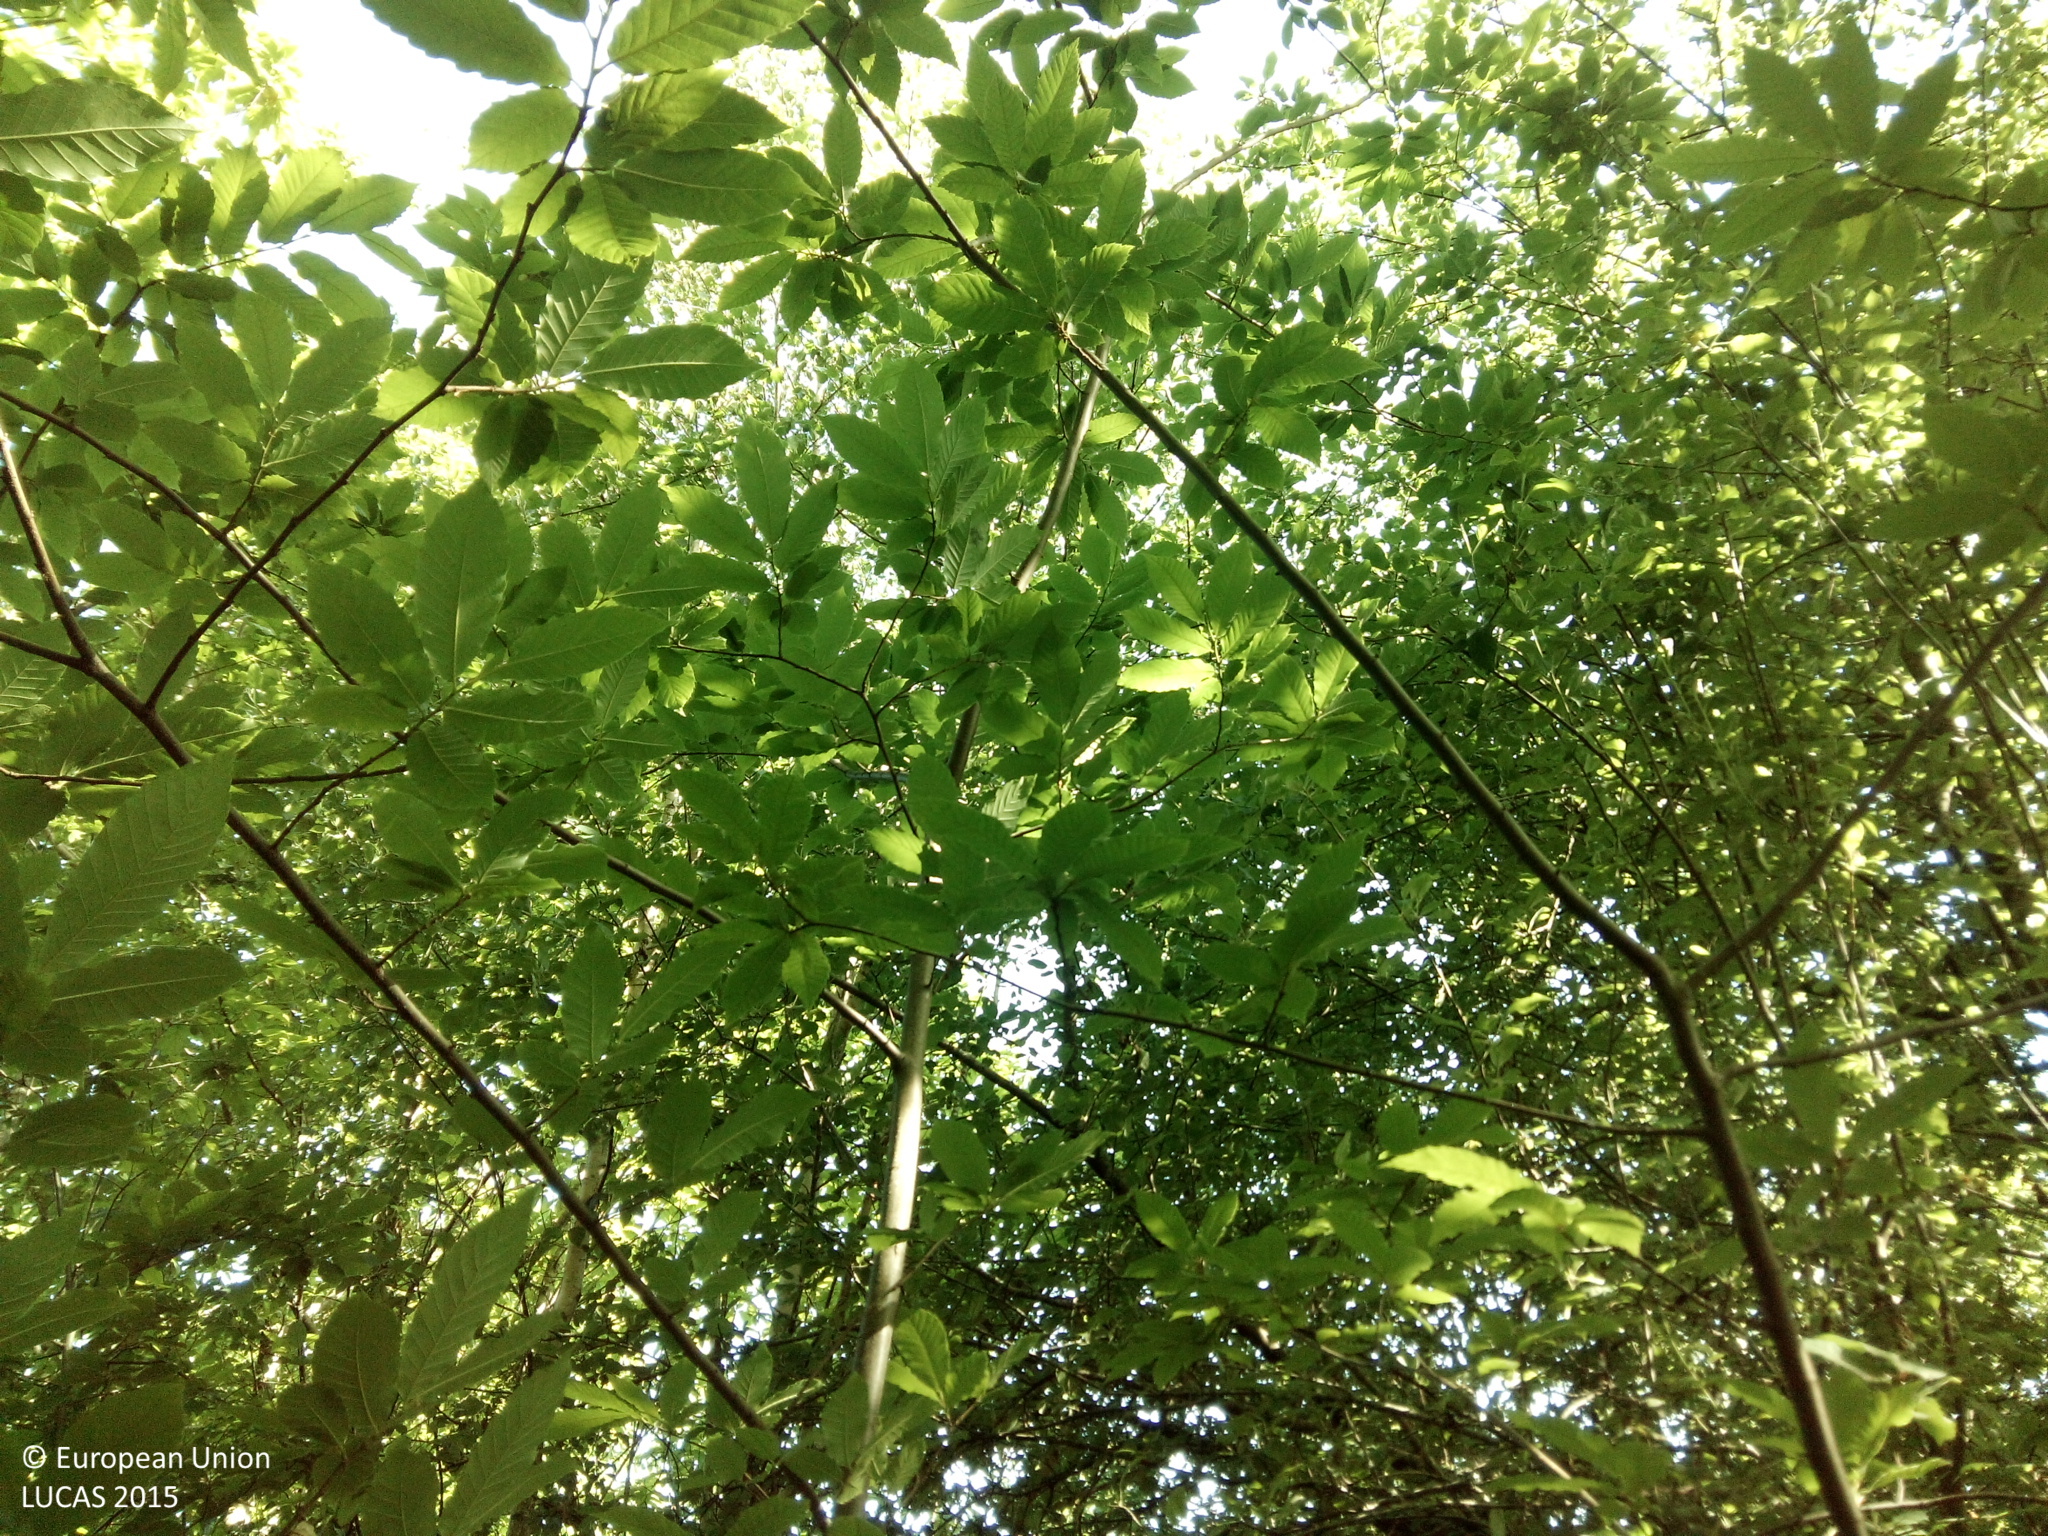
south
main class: Woodland
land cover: Broadleaved woodland
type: acidophilous oak and oak-birch forest
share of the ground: > 75 %
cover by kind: broadleaved forest trees 100 %
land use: Forestry
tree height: > 5 m
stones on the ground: 10 - 25 %
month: May
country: ES
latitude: 42.6800
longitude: -8.4408
